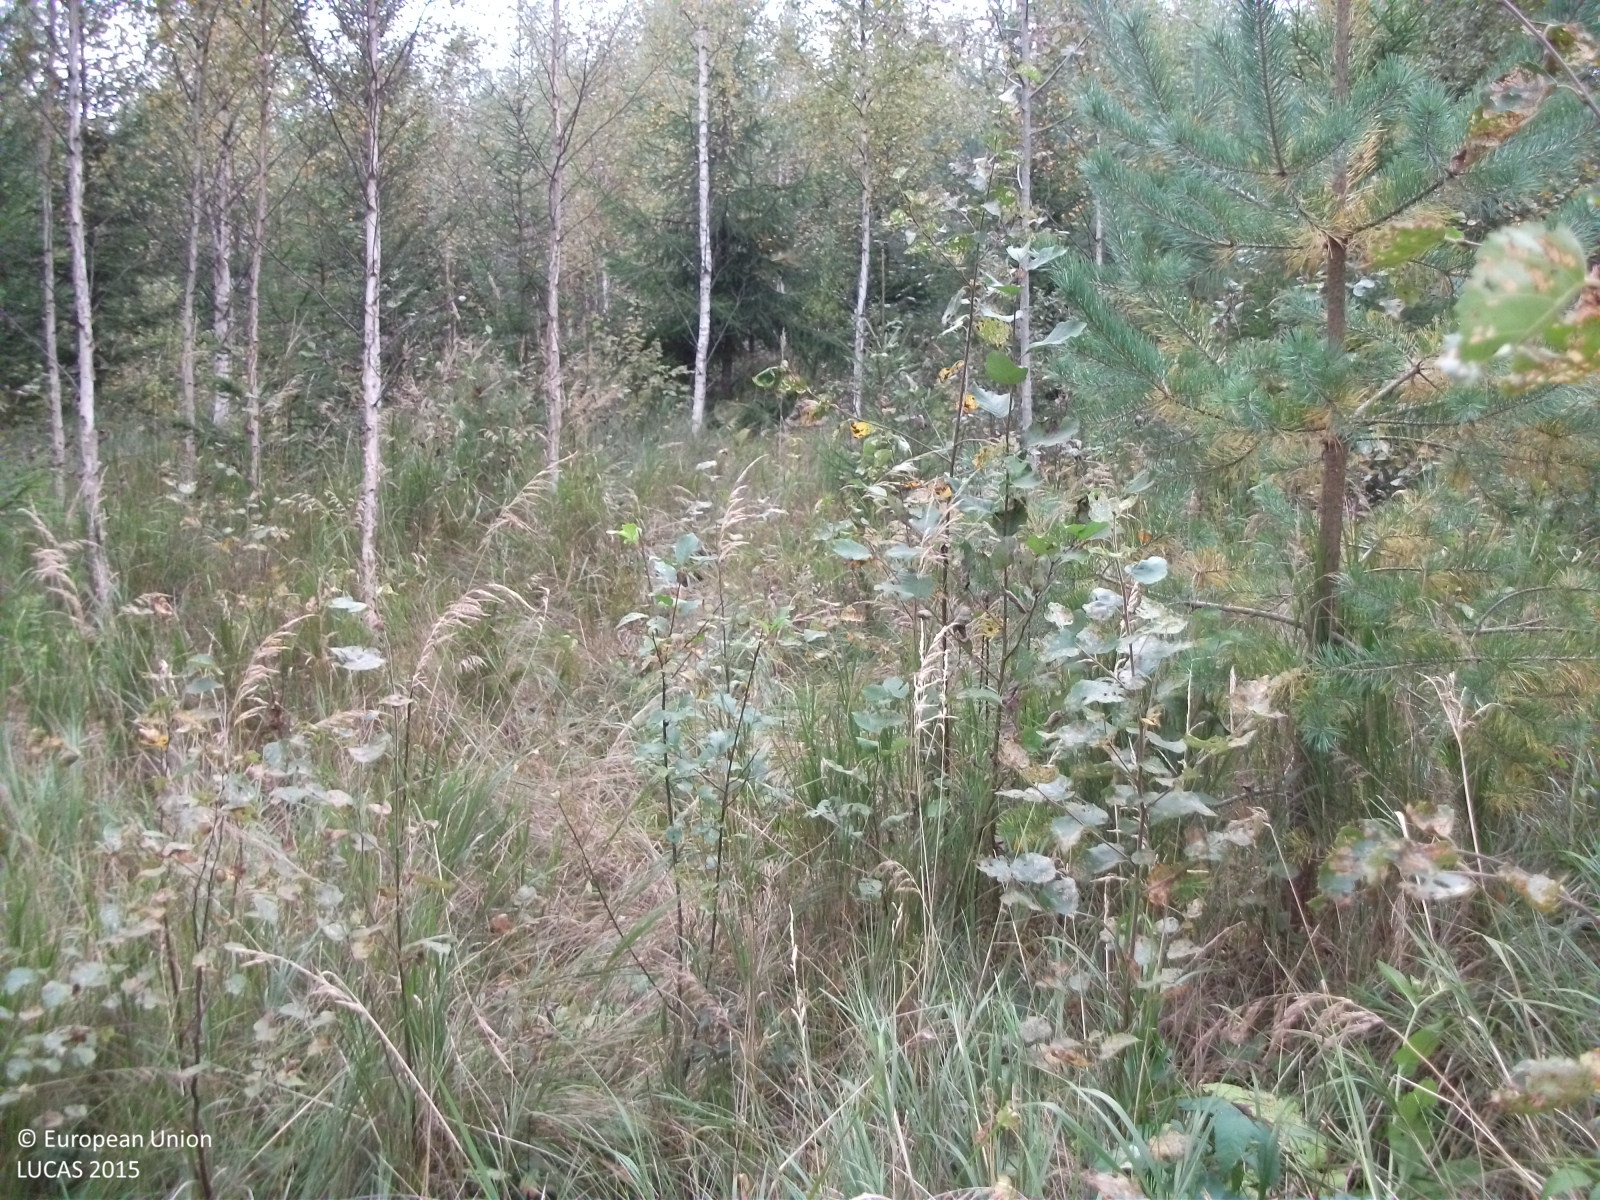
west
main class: Woodland
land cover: Other mixed woodland
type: hemiboreal forest and nemoral coniferous forest and mixed broadleaved-coniferous forest
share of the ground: 50 - 75 %
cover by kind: broadleaved forest trees 45 %, coniferous forest trees 25 %, herbaceous plants 20 %, shrubs 10 %
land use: Forestry
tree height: > 5 m
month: September
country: LV
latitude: 57.7644
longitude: 24.5979
